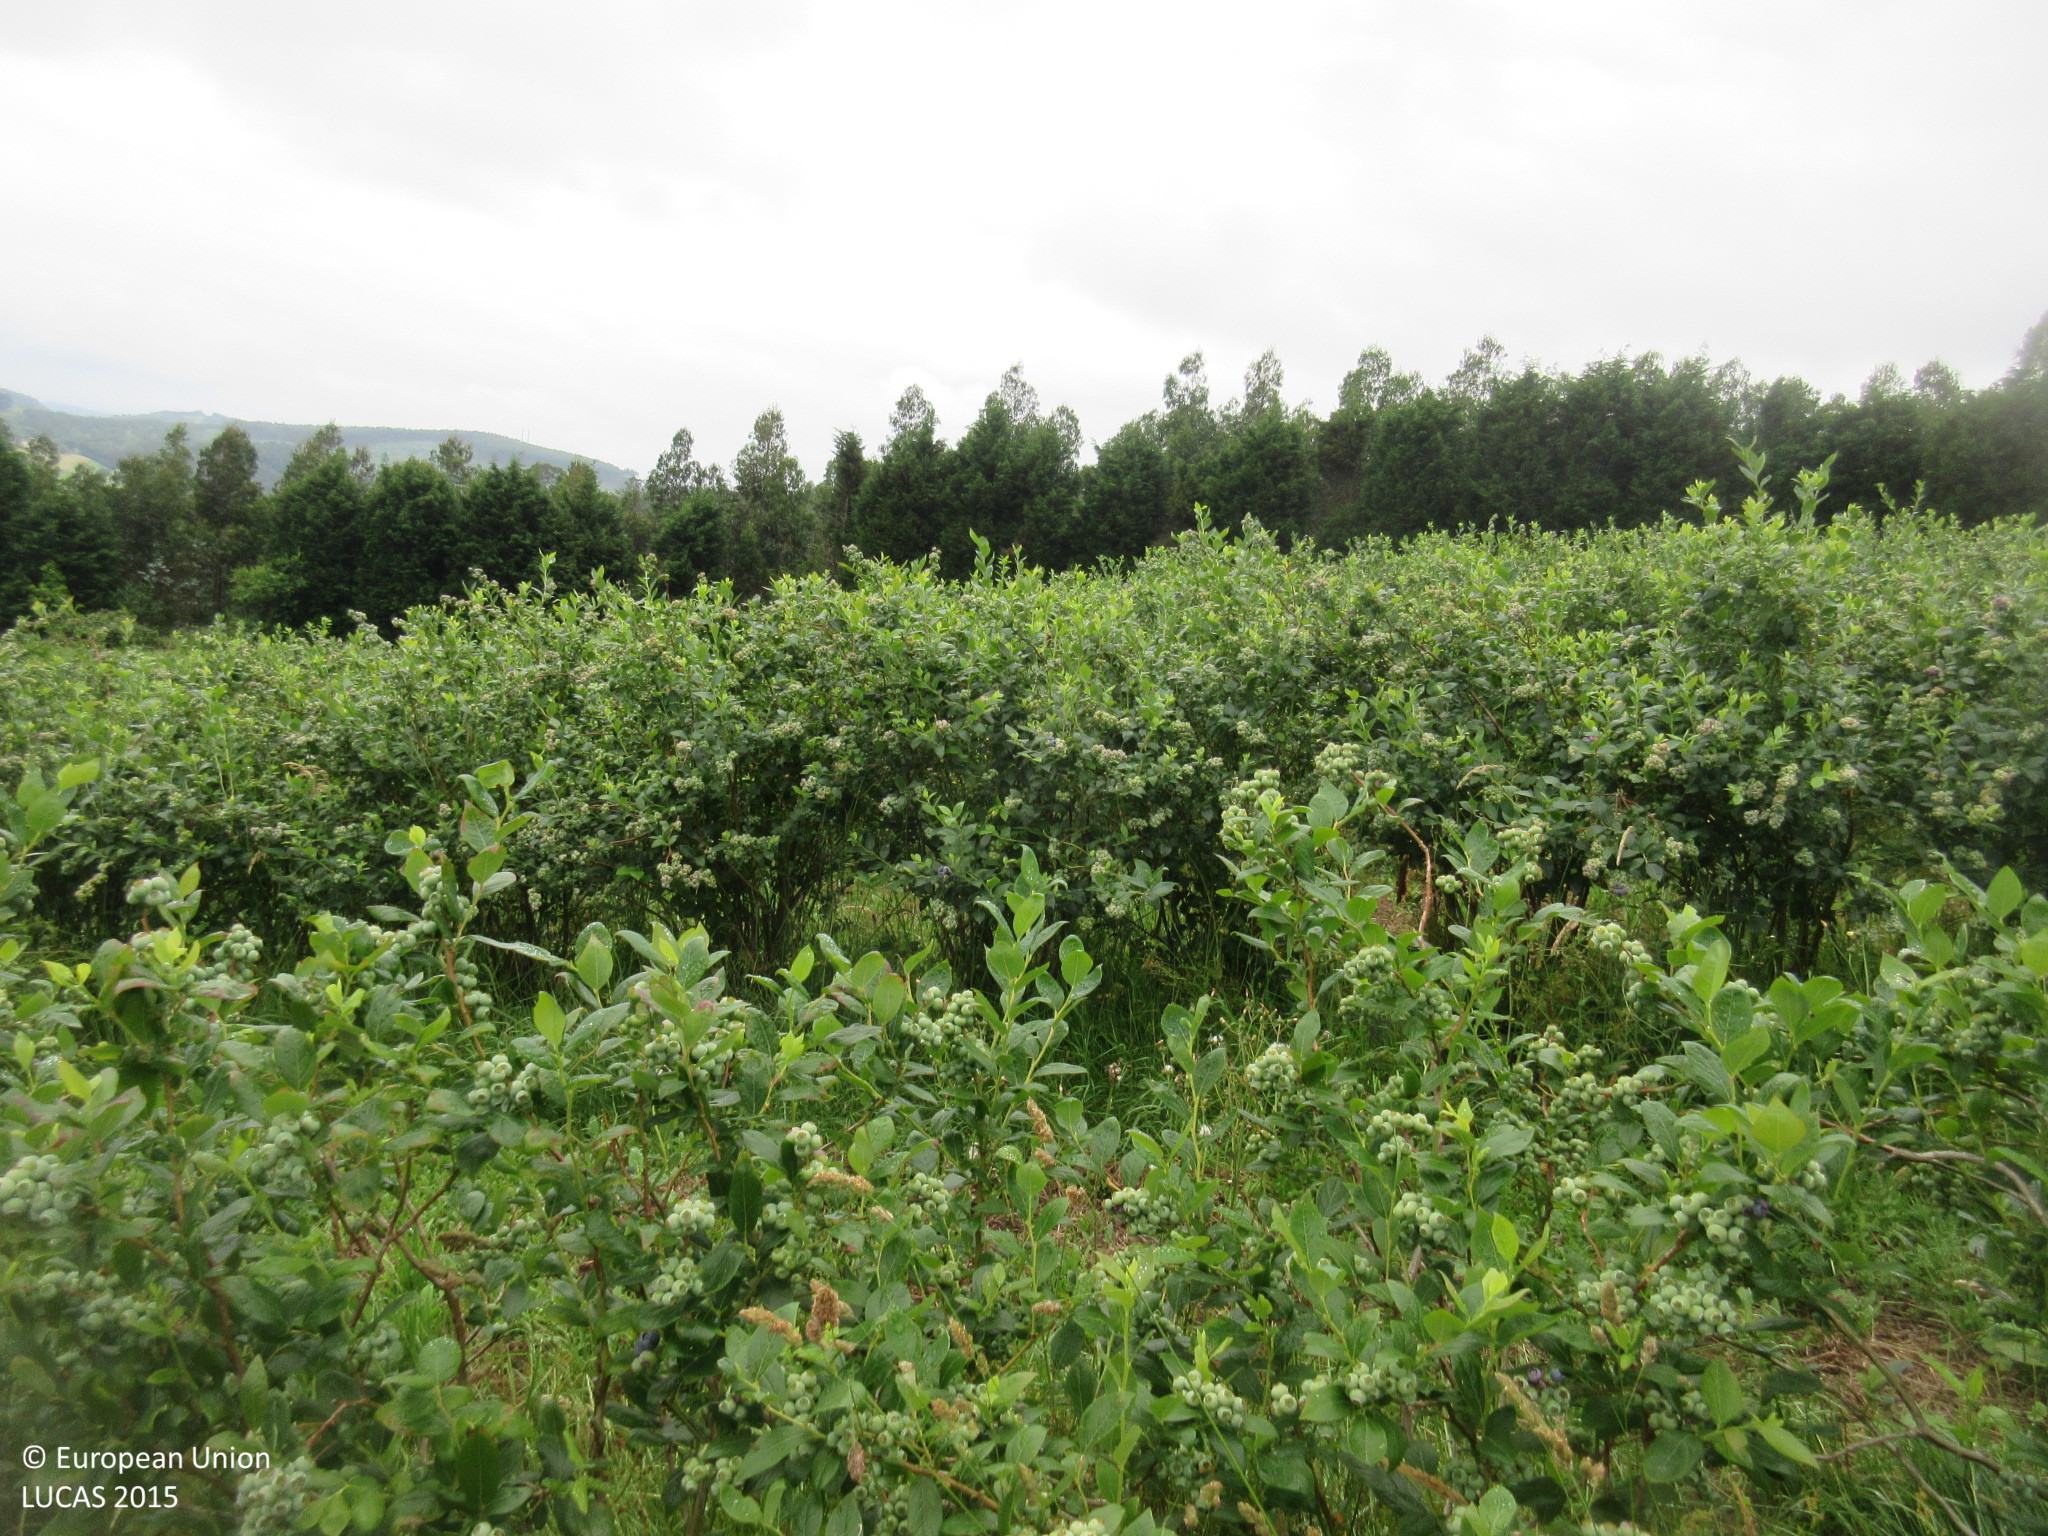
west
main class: Cropland
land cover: Other fruit trees and berries
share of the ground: 25 - 50 %
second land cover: Spontaneously vegetated surfaces
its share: > 75 %
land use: Agriculture (excluding fallow land and kitchen gardens)
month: June
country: ES
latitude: 43.4646
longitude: -3.6303
